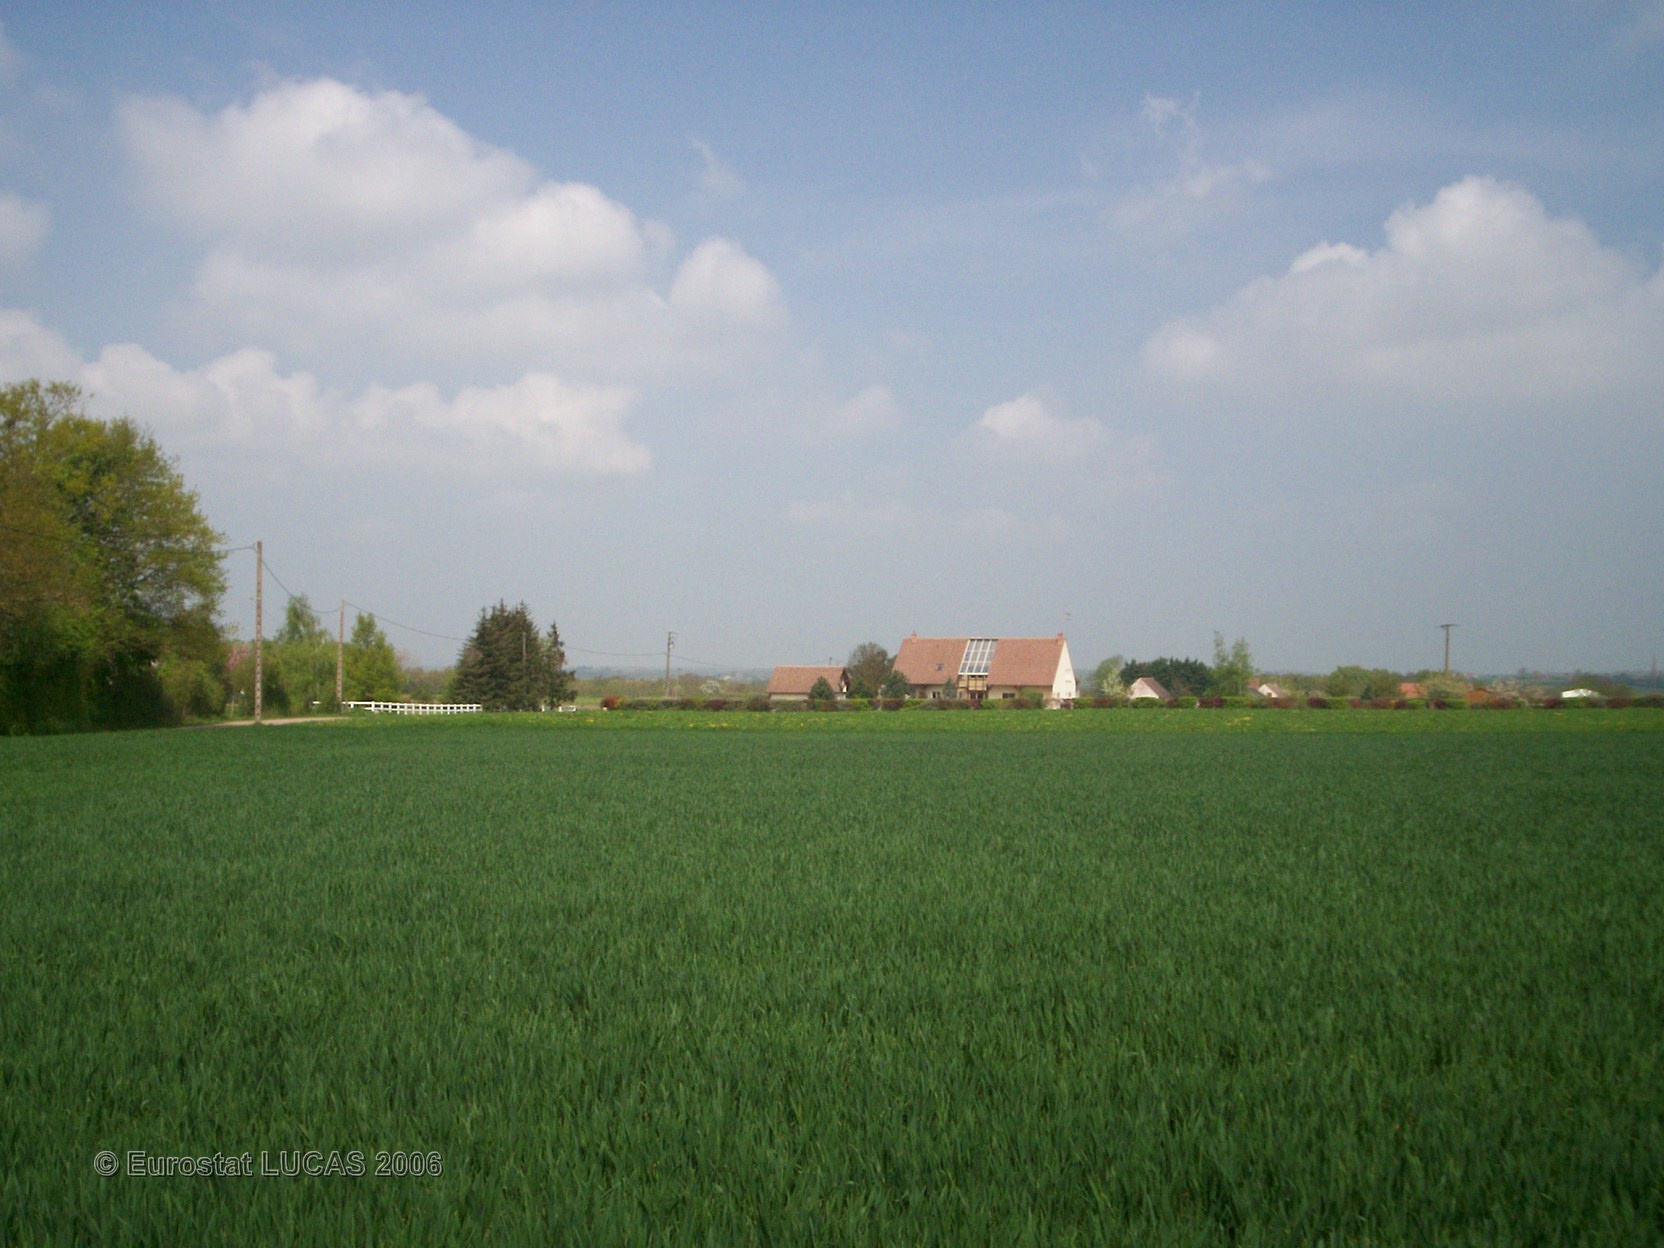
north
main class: Cropland
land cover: Common wheat
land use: Agriculture (excluding fallow land and kitchen gardens)
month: April
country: FR
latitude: 47.9214
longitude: 2.8866
